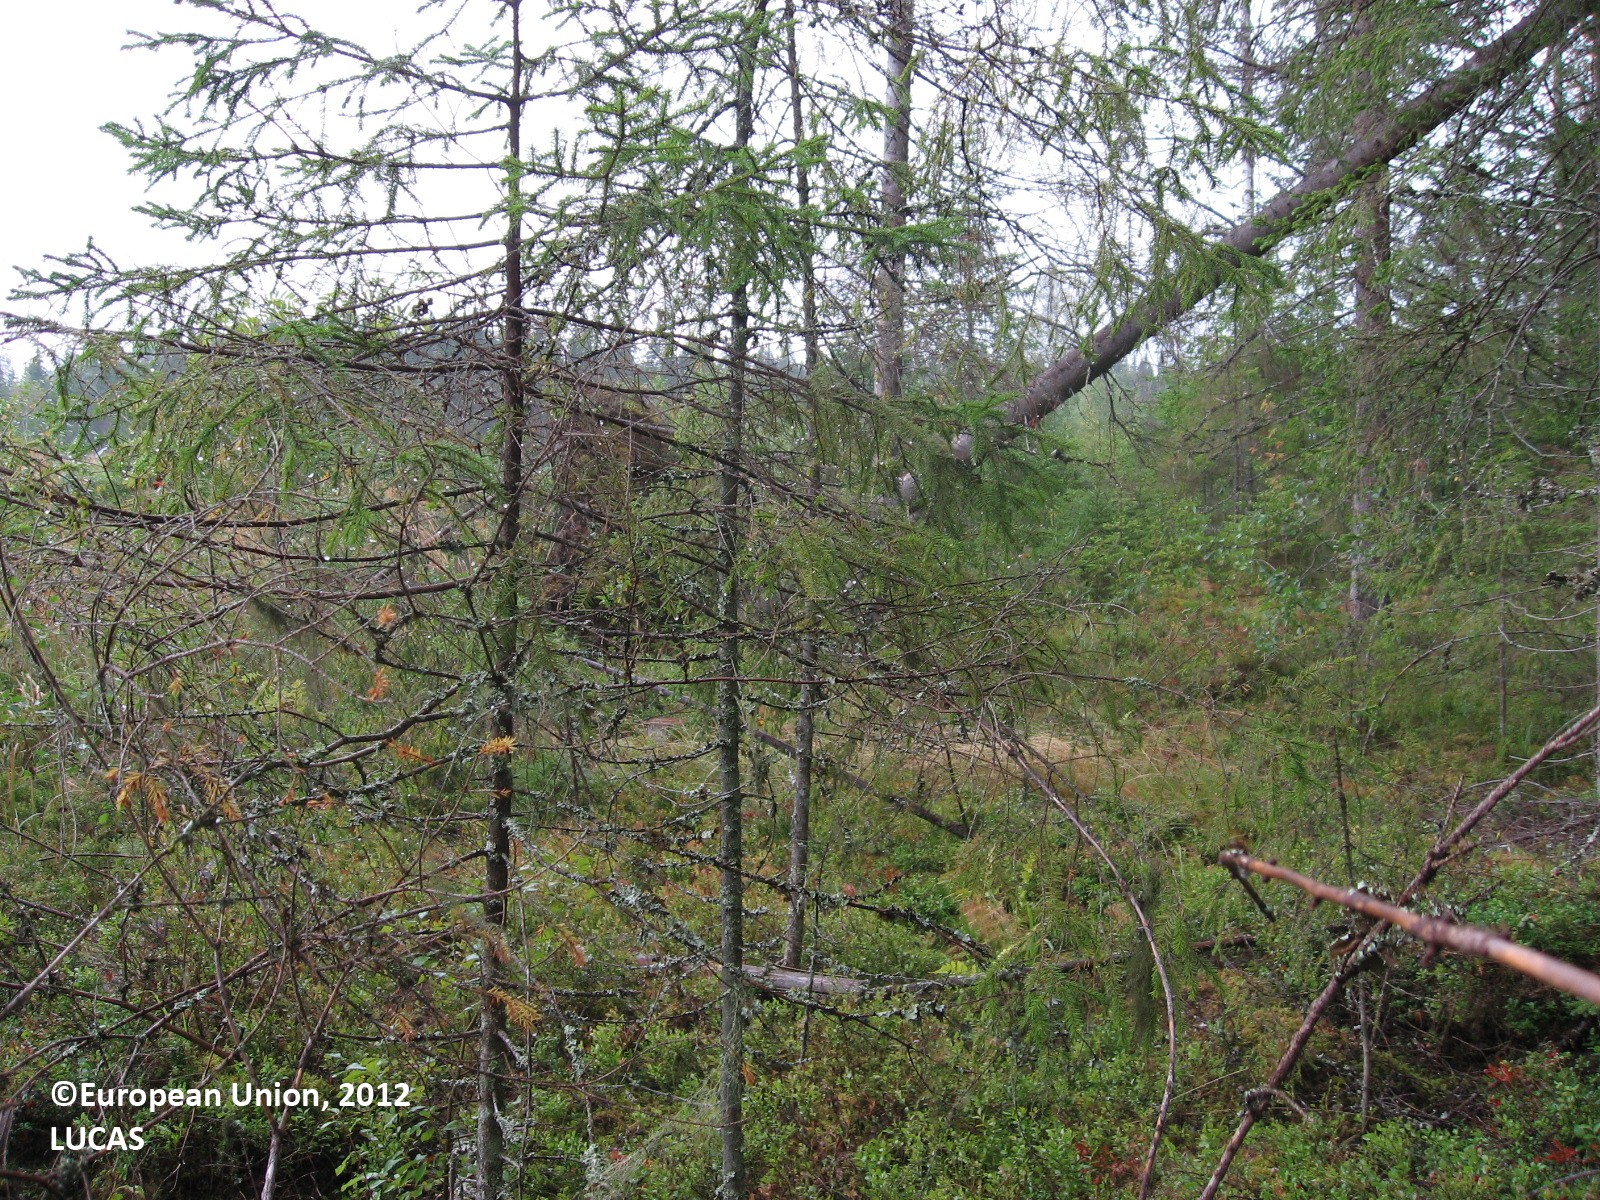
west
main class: Woodland
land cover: Spruce dominated mixed woodland
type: boreal forest
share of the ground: > 75 %
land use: Forestry
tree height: > 5 m
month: August
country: FI
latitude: 61.3598
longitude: 24.9787
